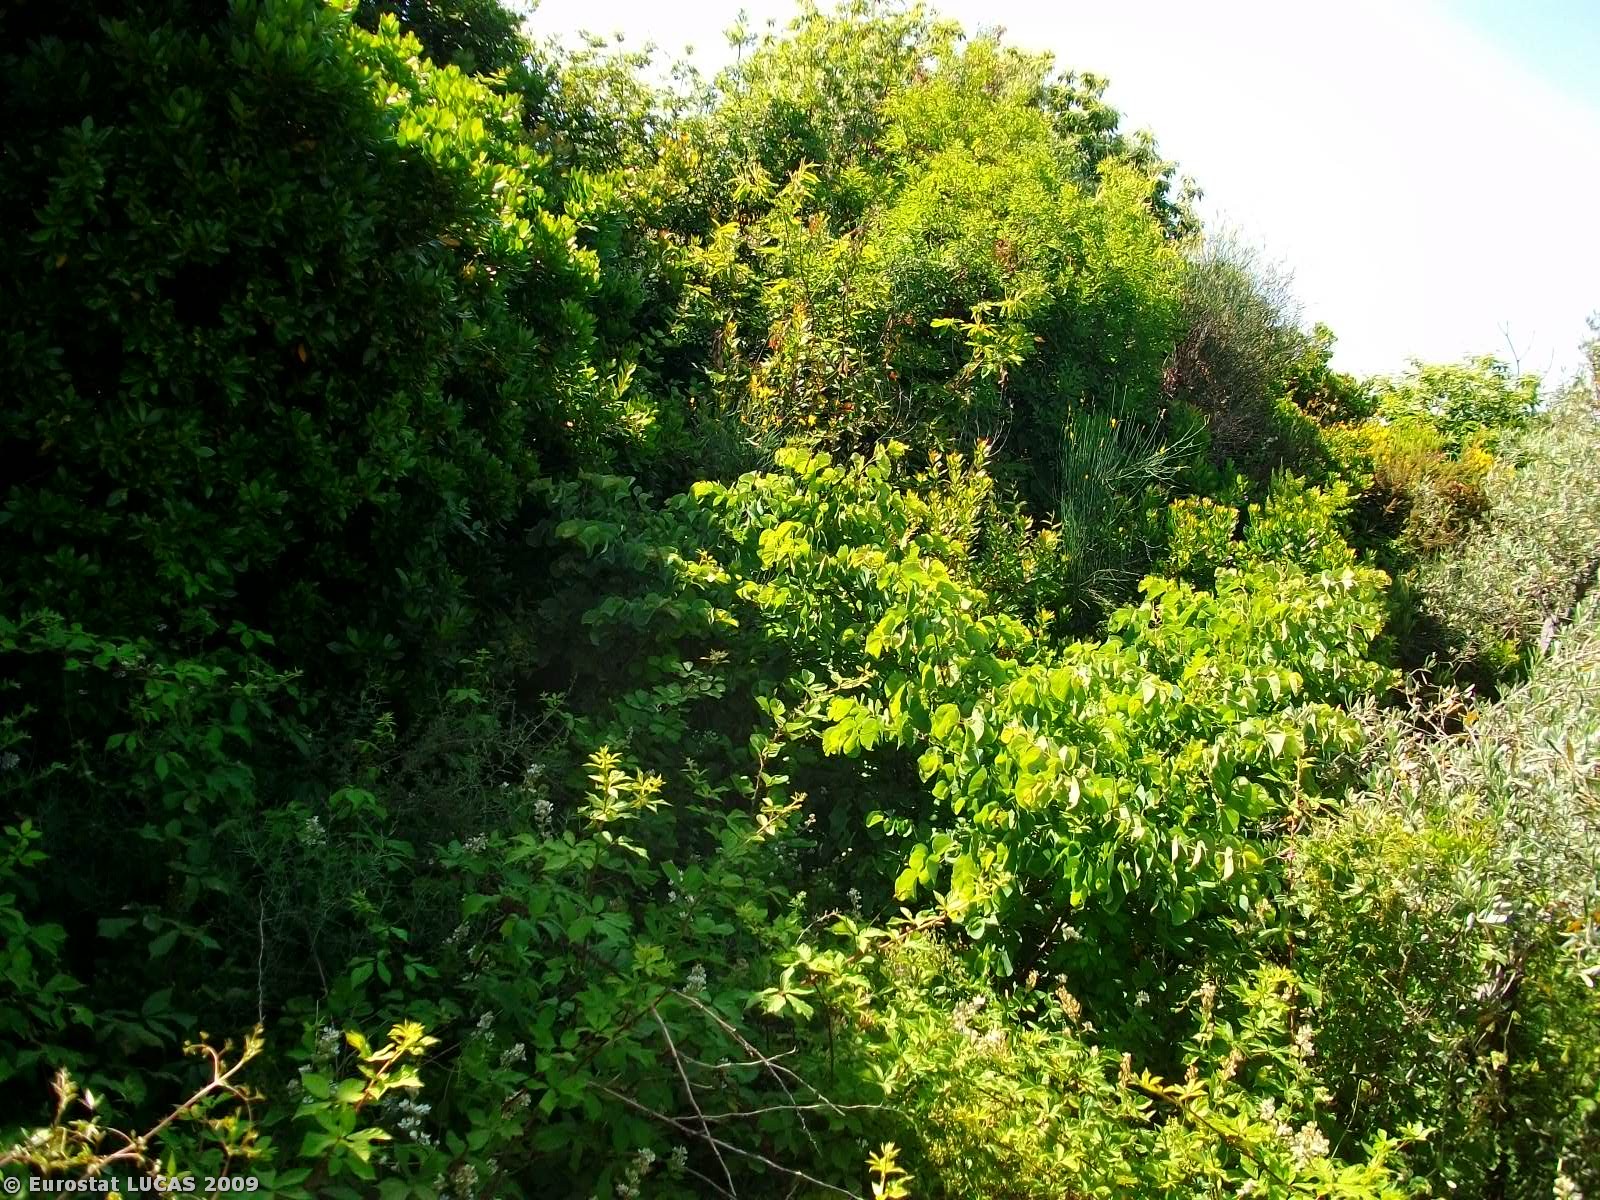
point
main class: Shrubland
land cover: Shrubland with sparse tree cover
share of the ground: > 75 %
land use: Nature reserves
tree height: < 5 m
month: June
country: GR
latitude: 39.3513
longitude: 23.2114
